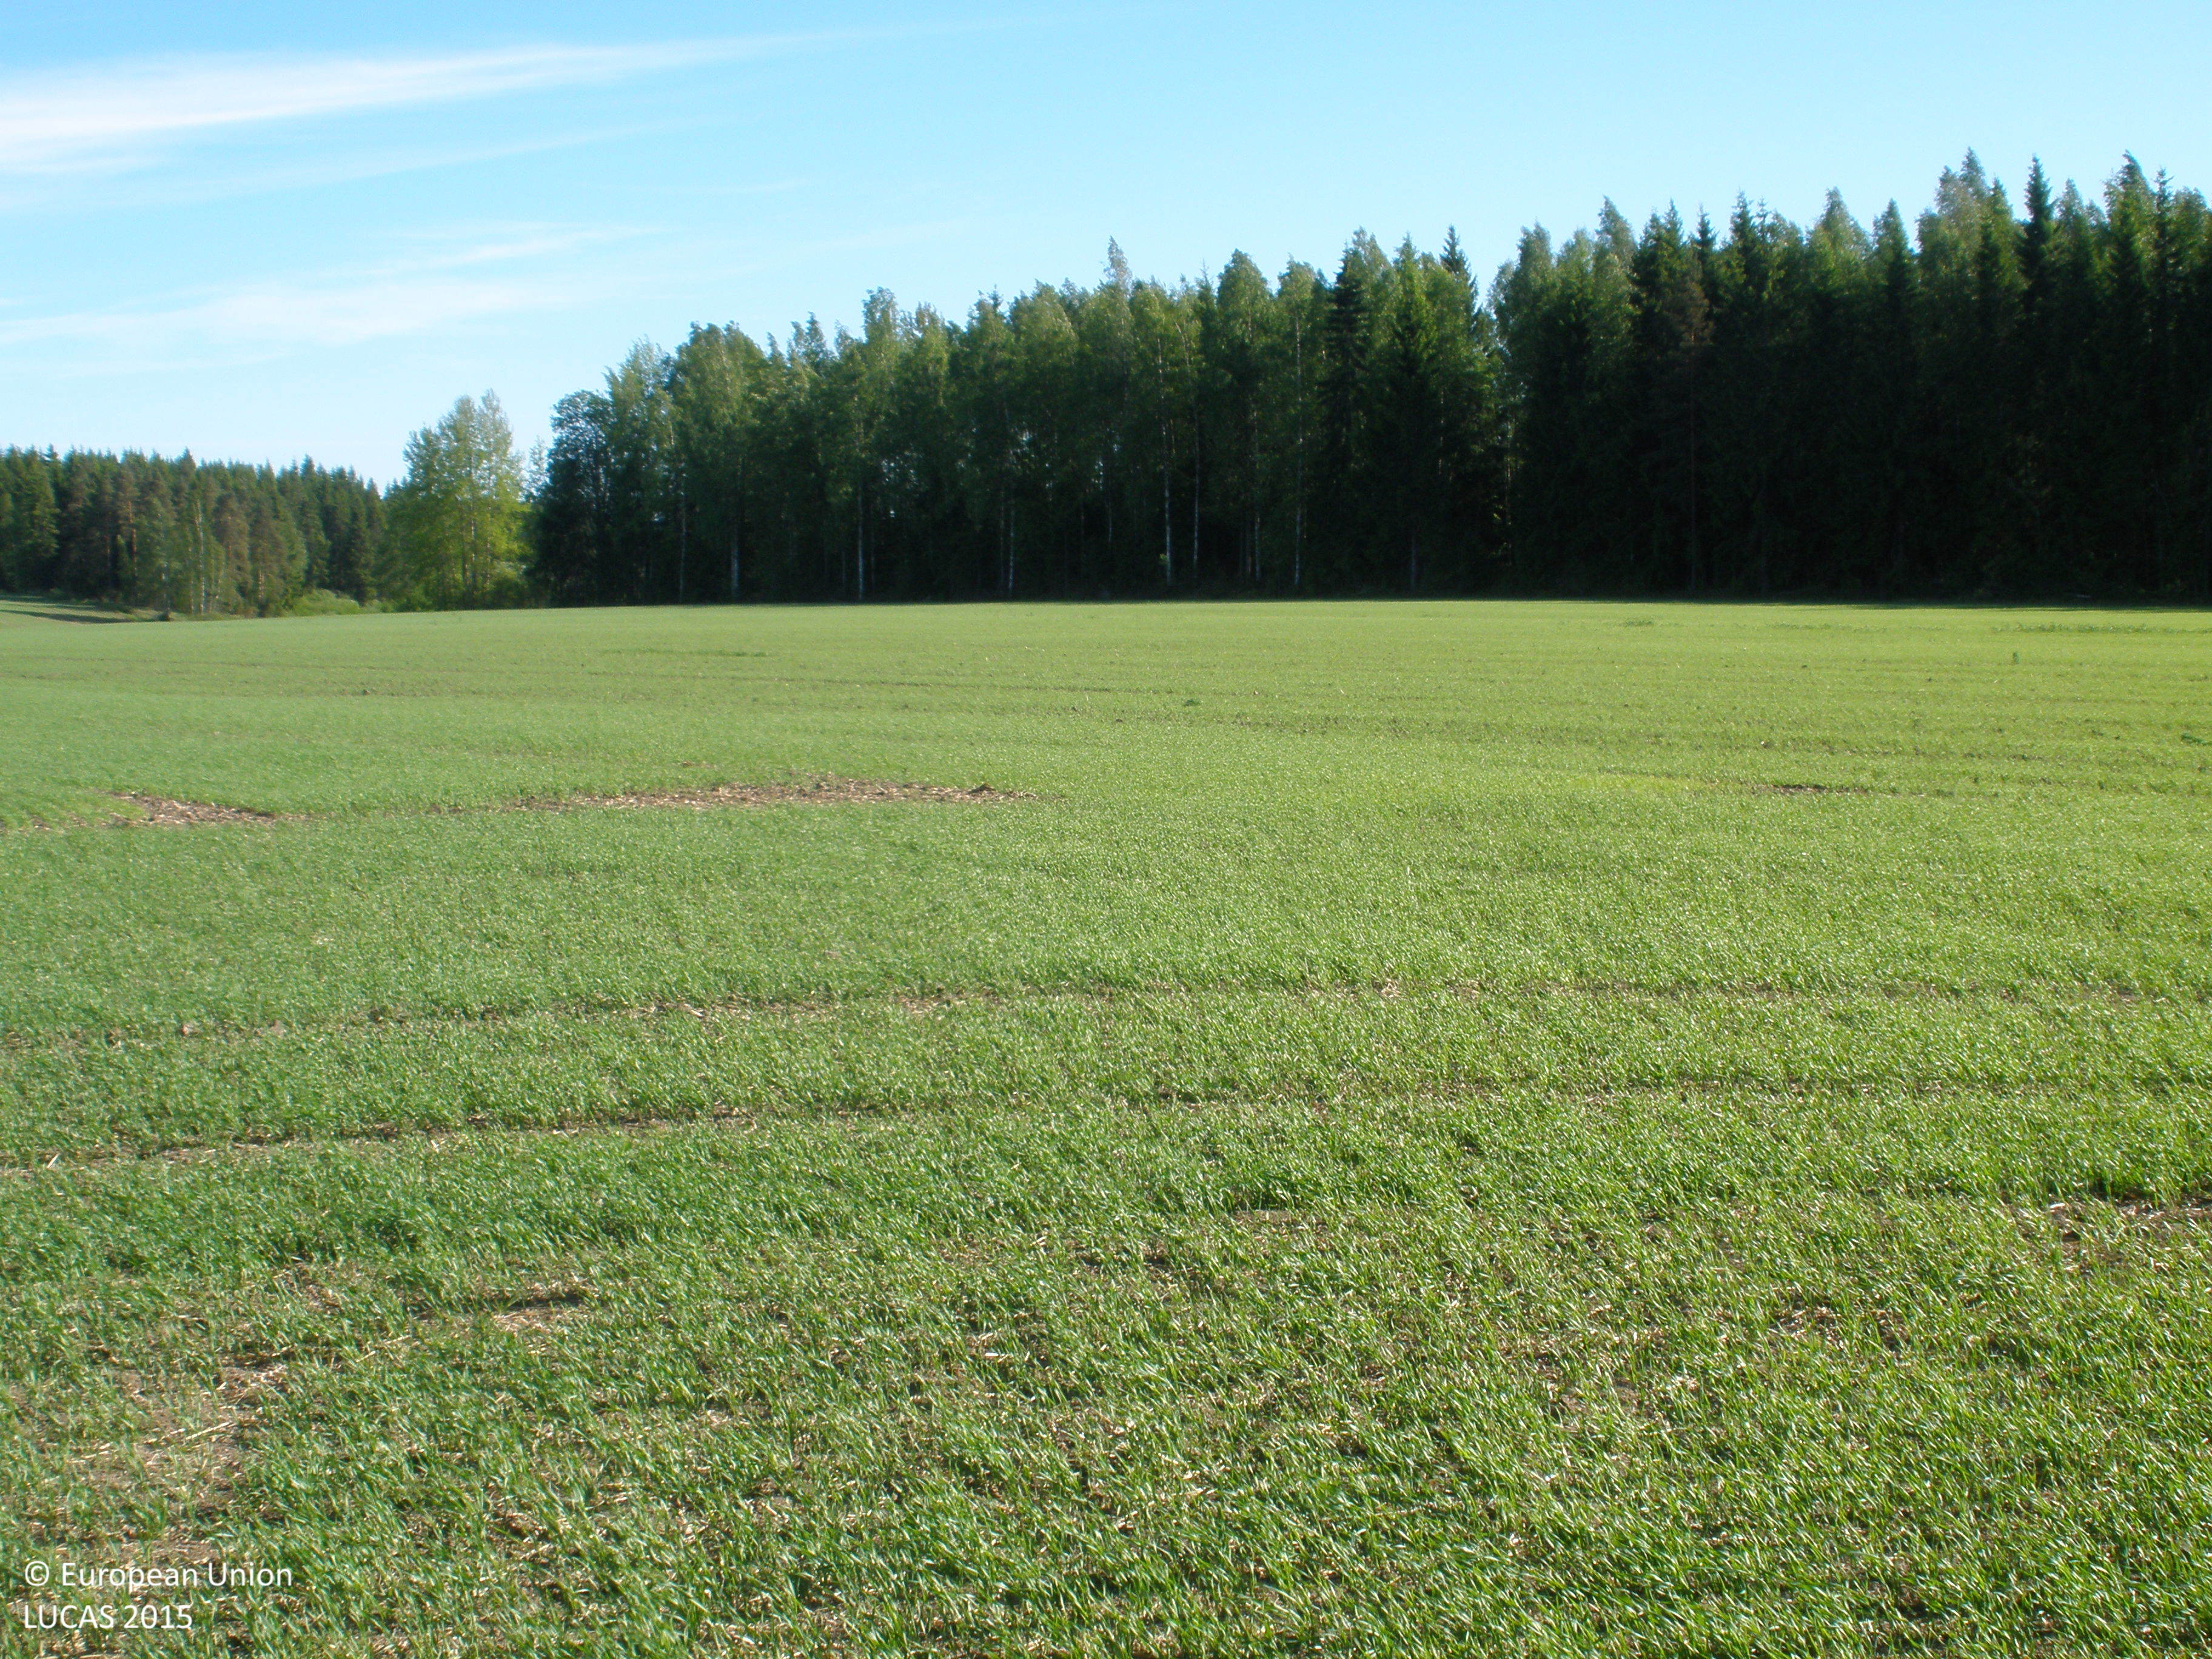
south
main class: Cropland
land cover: Common wheat
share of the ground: > 75 %
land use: Agriculture (excluding fallow land and kitchen gardens)
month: June
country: FI
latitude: 60.7613
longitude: 23.4264
